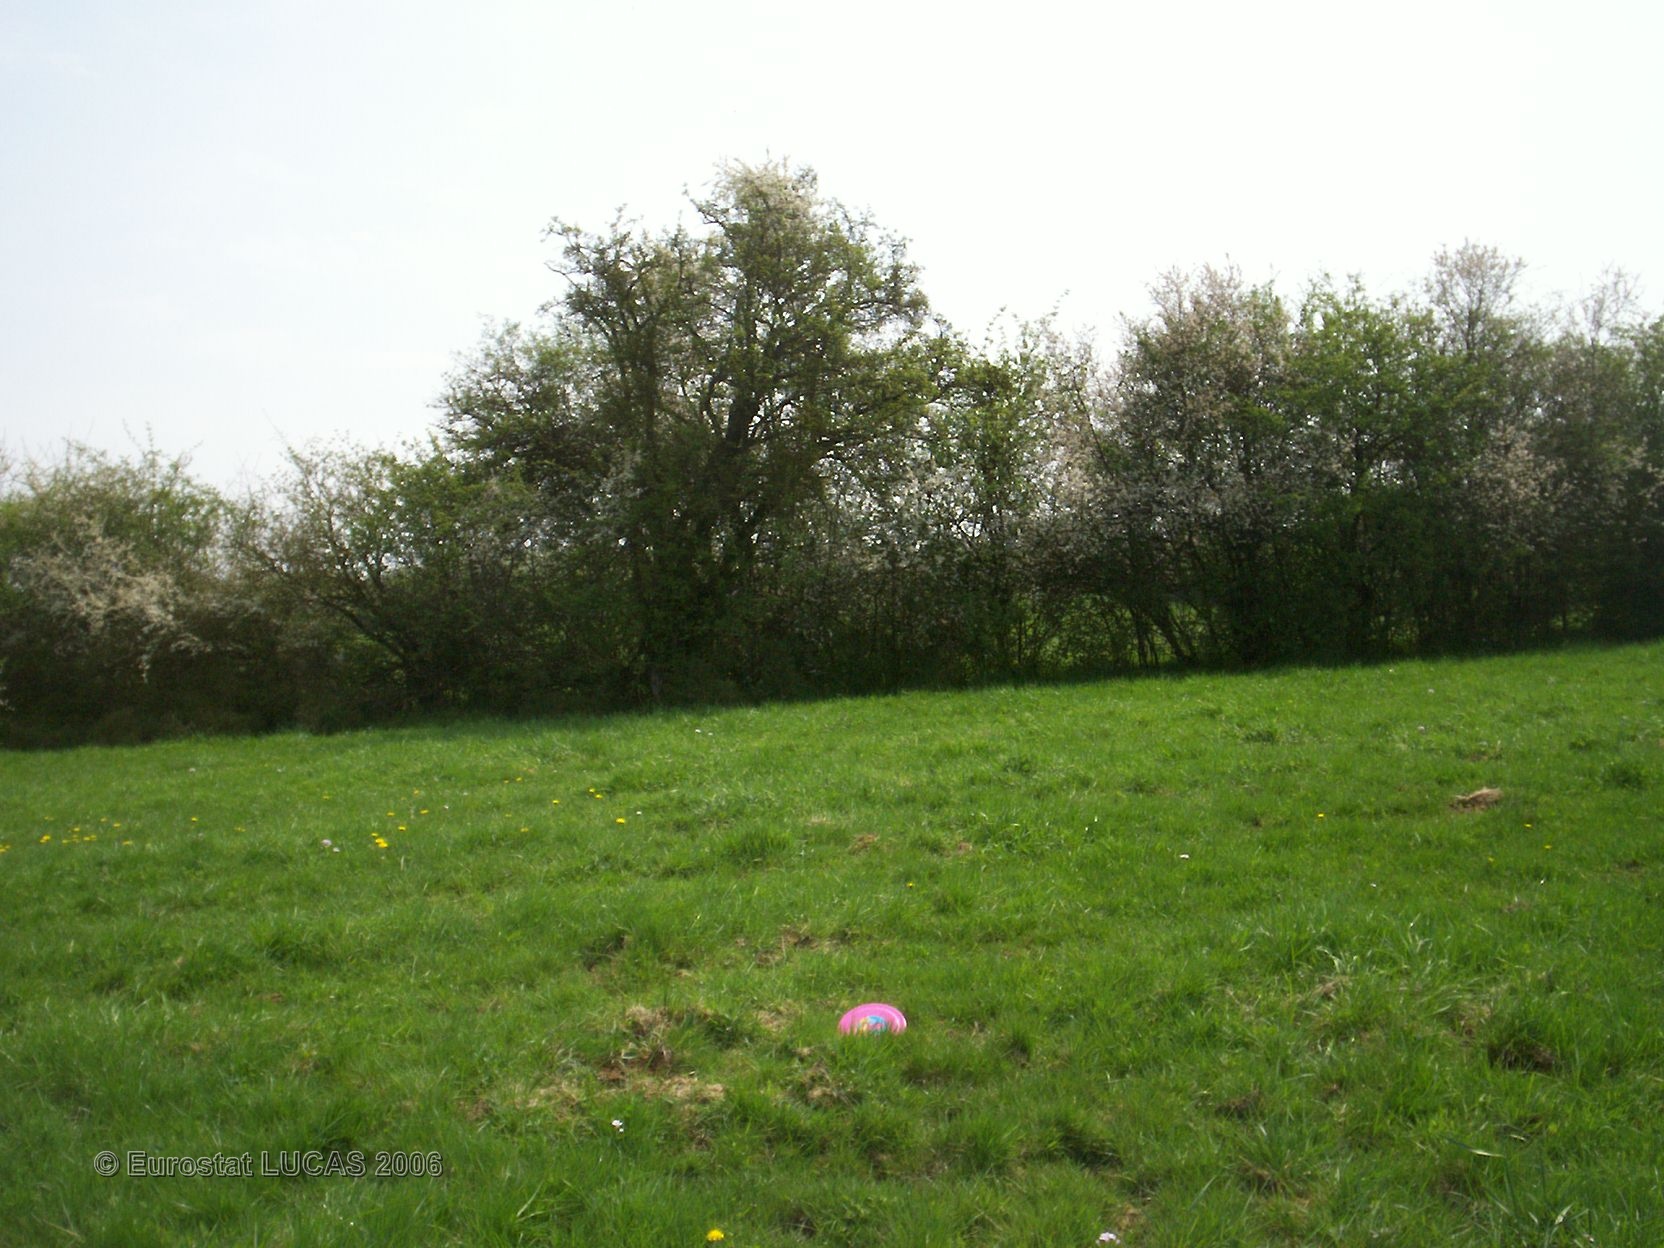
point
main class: Grassland
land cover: Grassland without tree/shrub cover
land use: Agriculture (excluding fallow land and kitchen gardens)
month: May
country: FR
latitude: 49.8796
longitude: 4.3037
